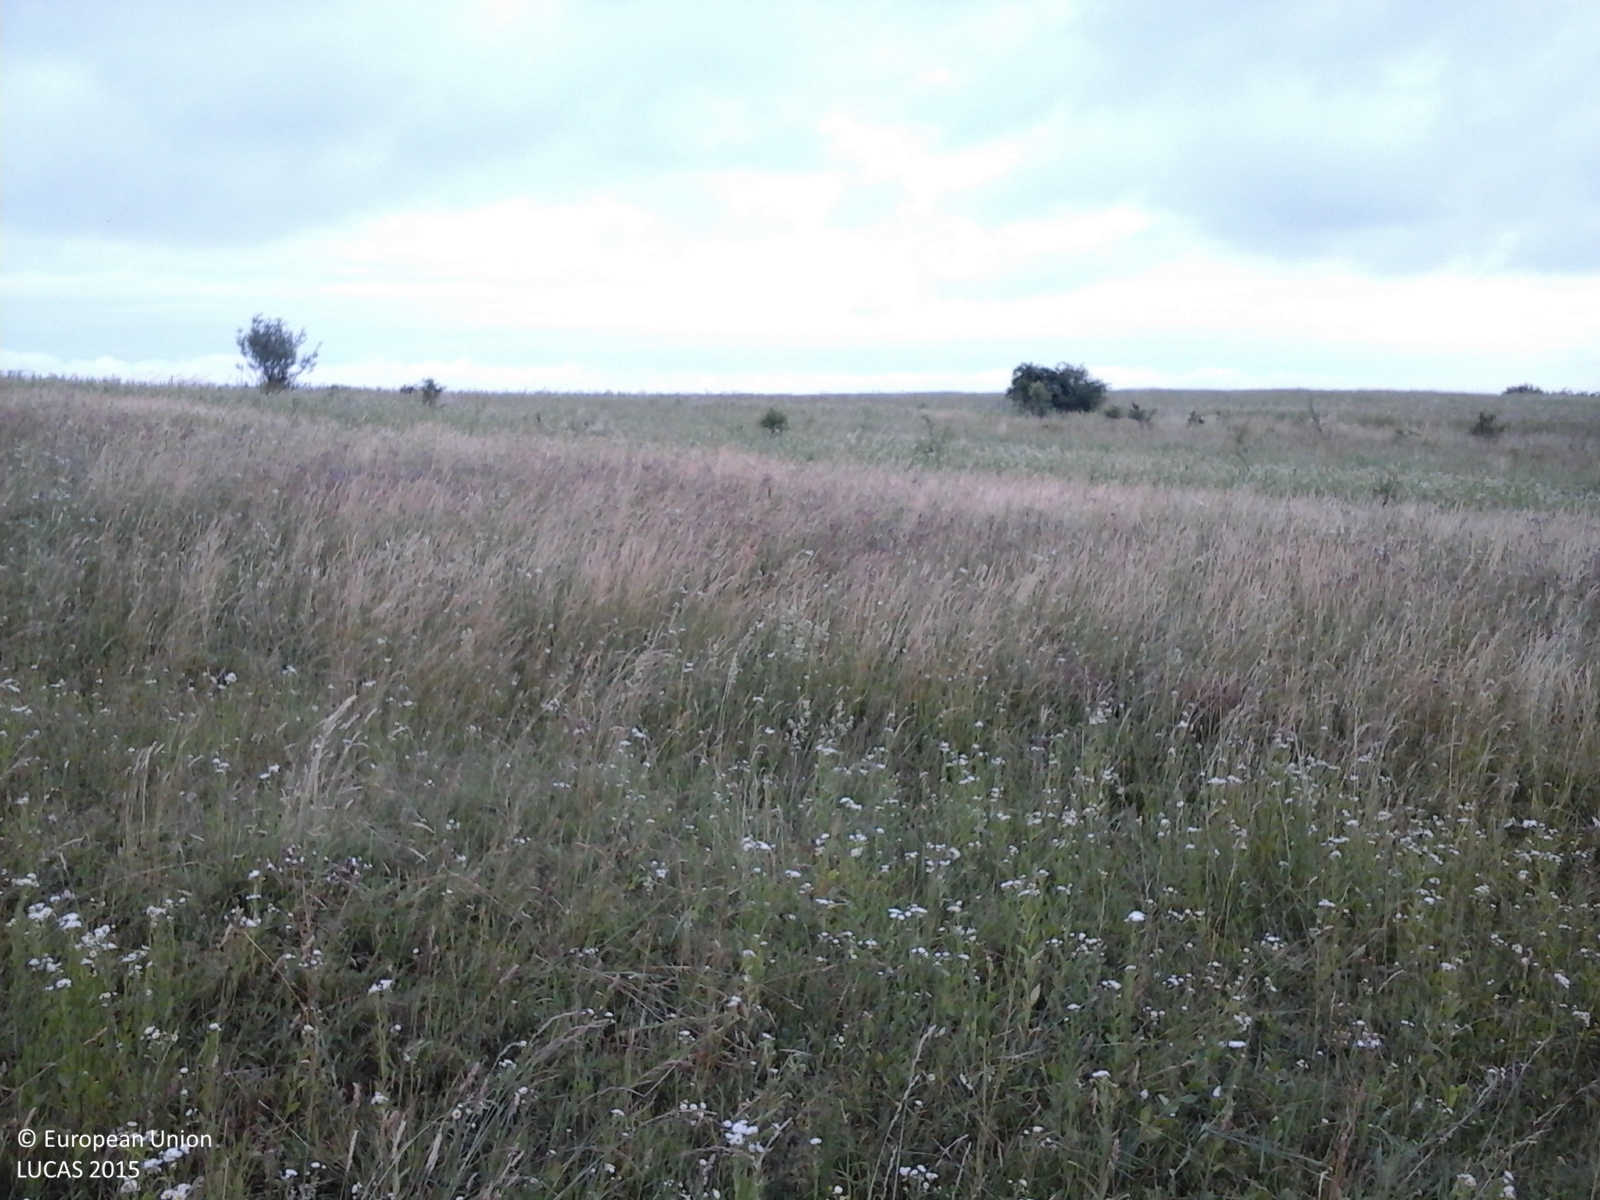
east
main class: Grassland
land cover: Grassland without tree/shrub cover
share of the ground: > 75 %
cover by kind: herbaceous plants 100 %
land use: Agriculture (excluding fallow land and kitchen gardens)
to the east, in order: Grassland without tree/shrub cover; Spontaneously vegetated surfaces; Grassland without tree/shrub cover; Electric lines; Grassland without tree/shrub cover; Spontaneously vegetated surfaces; Lines of trees; Grass margins; Ditches and canals; Grass margins; Paved roads, cycling and walking lanes; Grass margins; Ditches and canals; Grass margins; Lines of trees; Grassland without tree/shrub cover
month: June
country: RO
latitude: 47.9694
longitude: 25.9498
